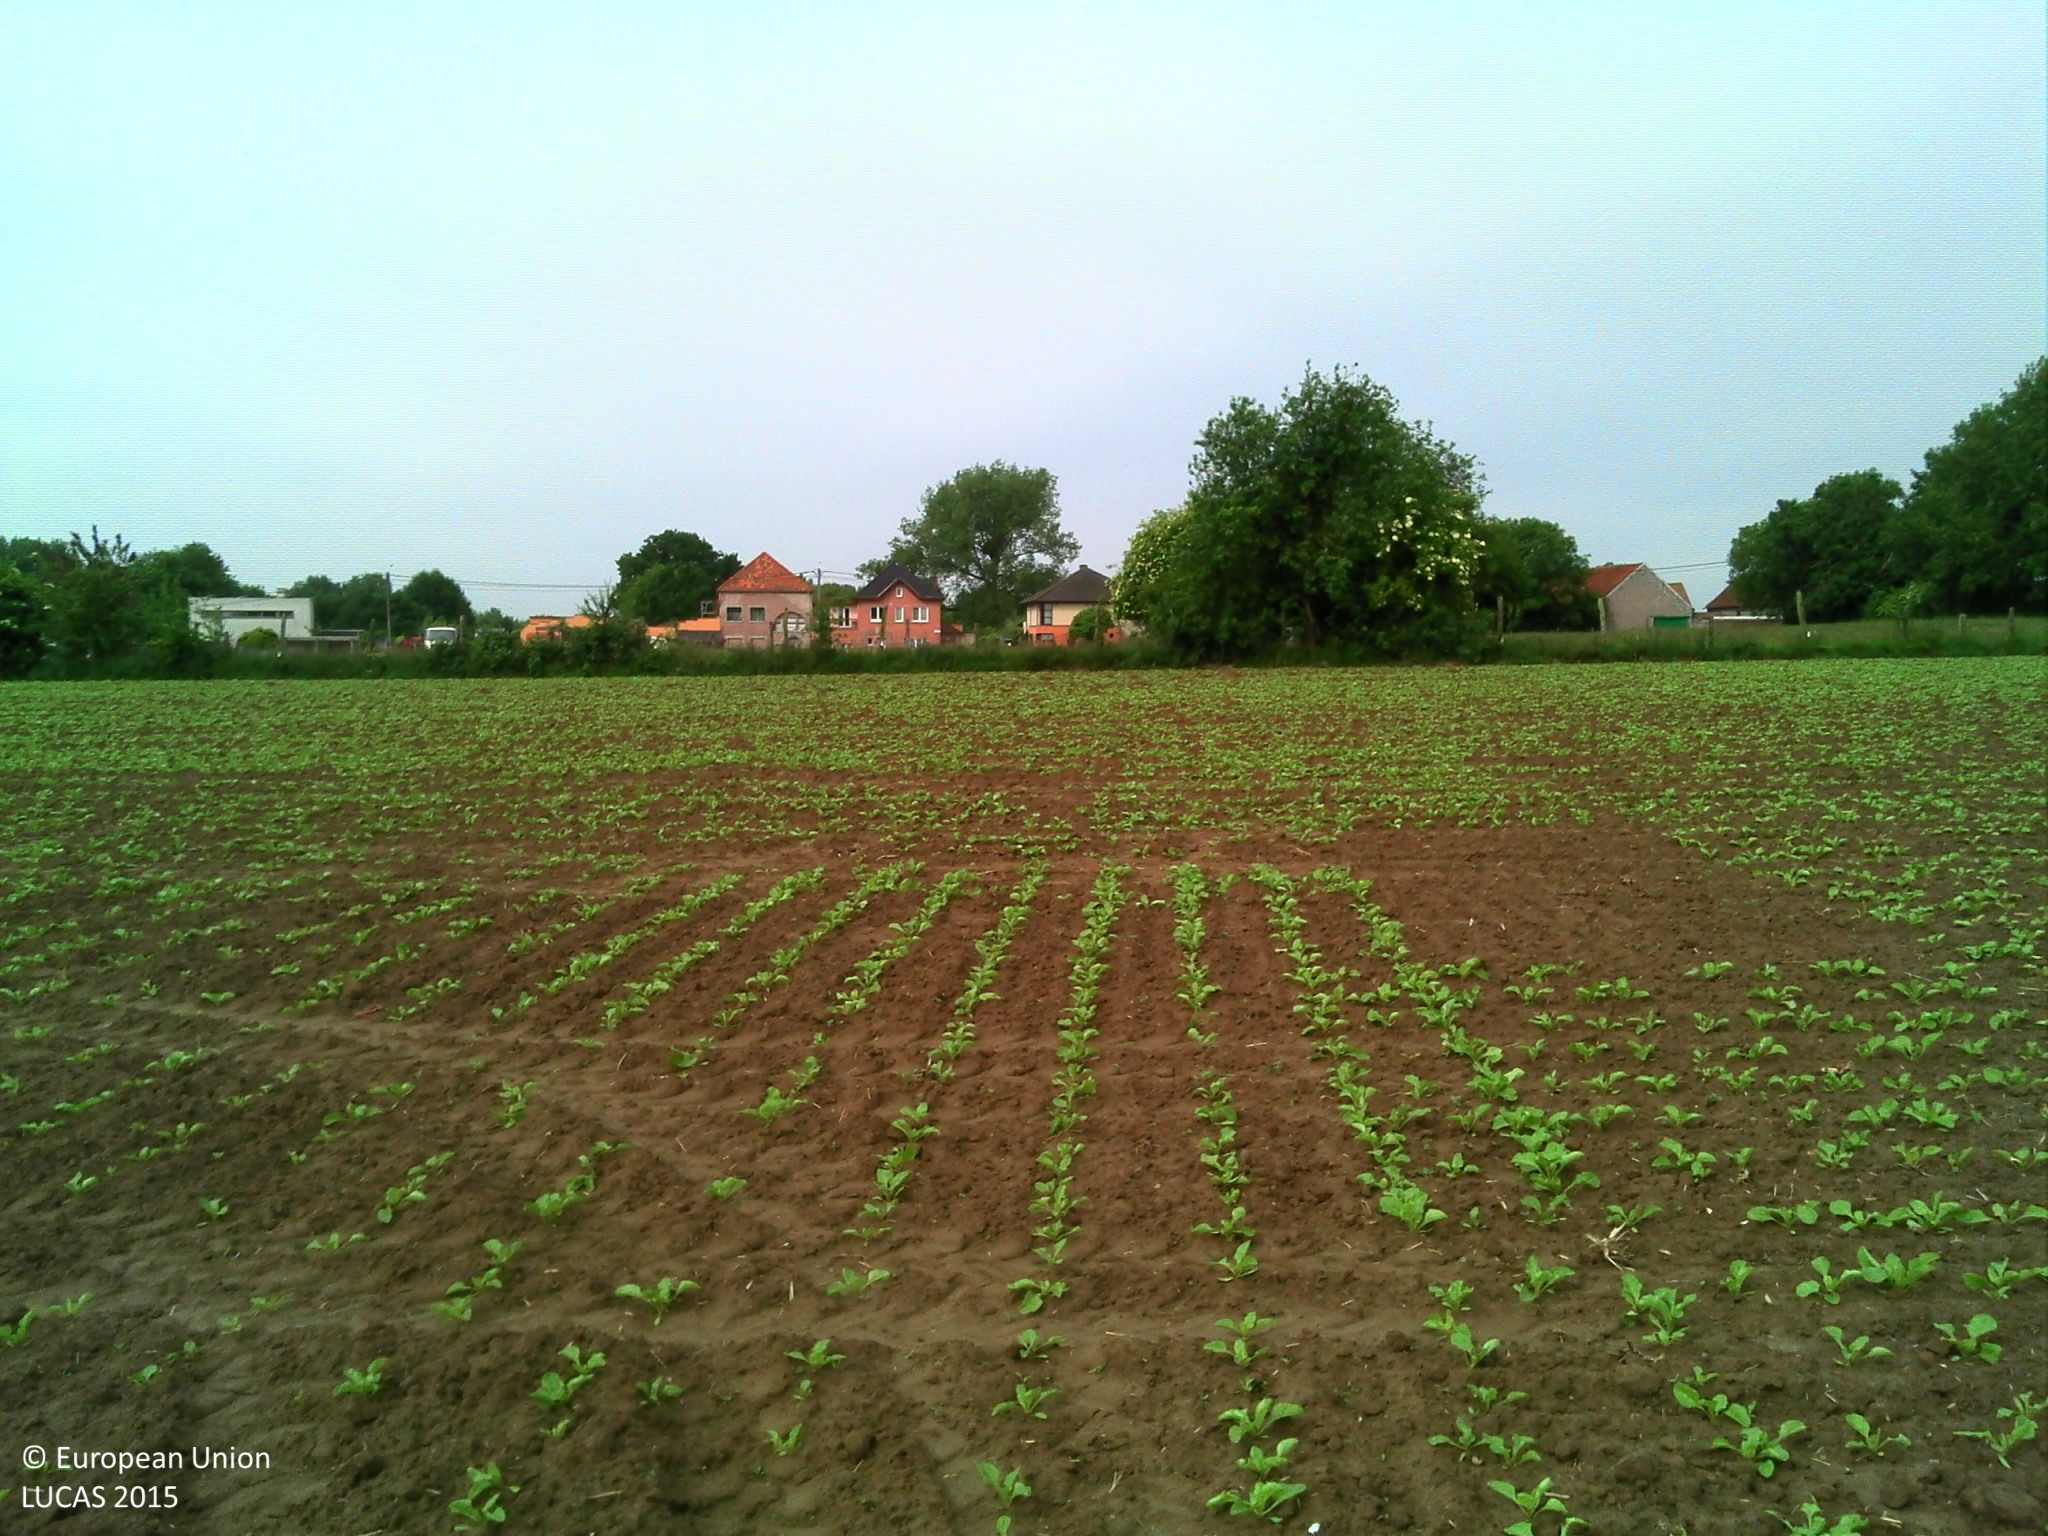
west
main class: Cropland
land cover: Sugar beet
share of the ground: 10 - 25 %
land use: Agriculture (excluding fallow land and kitchen gardens)
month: June
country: BE
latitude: 50.8264
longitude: 4.1314
